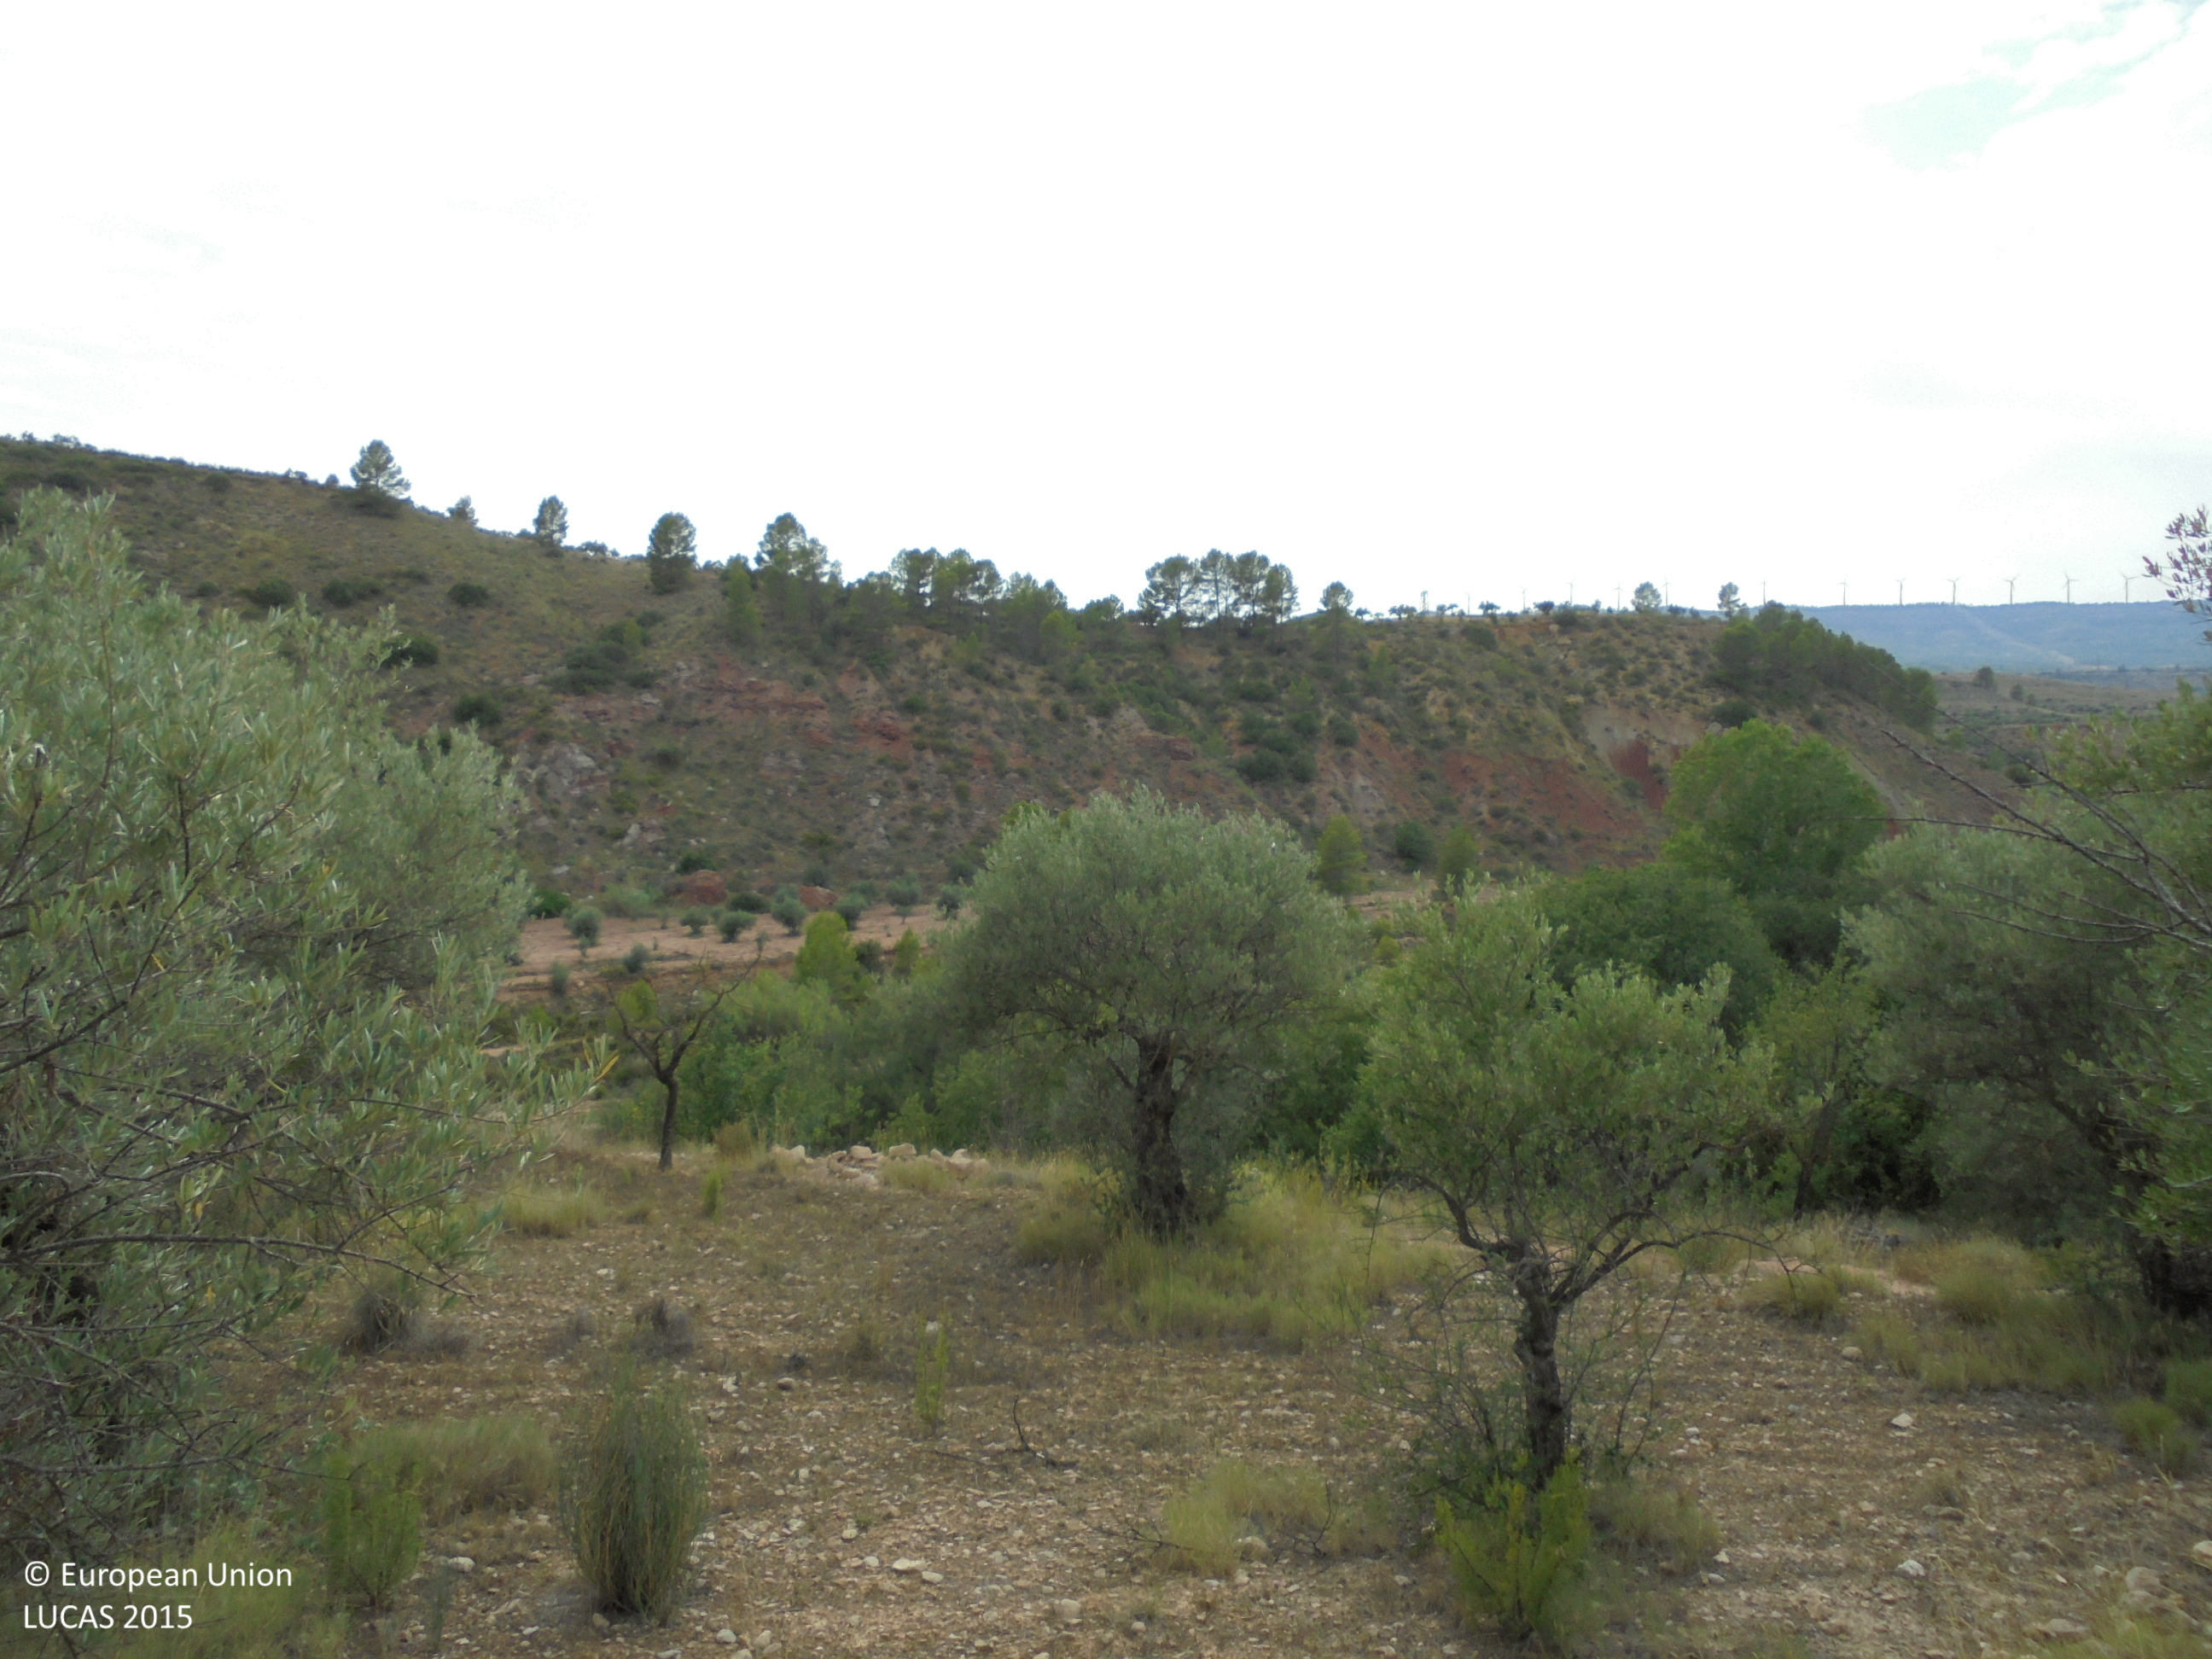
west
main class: Cropland
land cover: Olive groves
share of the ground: 25 - 50 %
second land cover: Shrubland without tree cover
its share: 25 - 50 %
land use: Abandoned areas
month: August
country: ES
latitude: 39.1486
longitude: -1.0474
